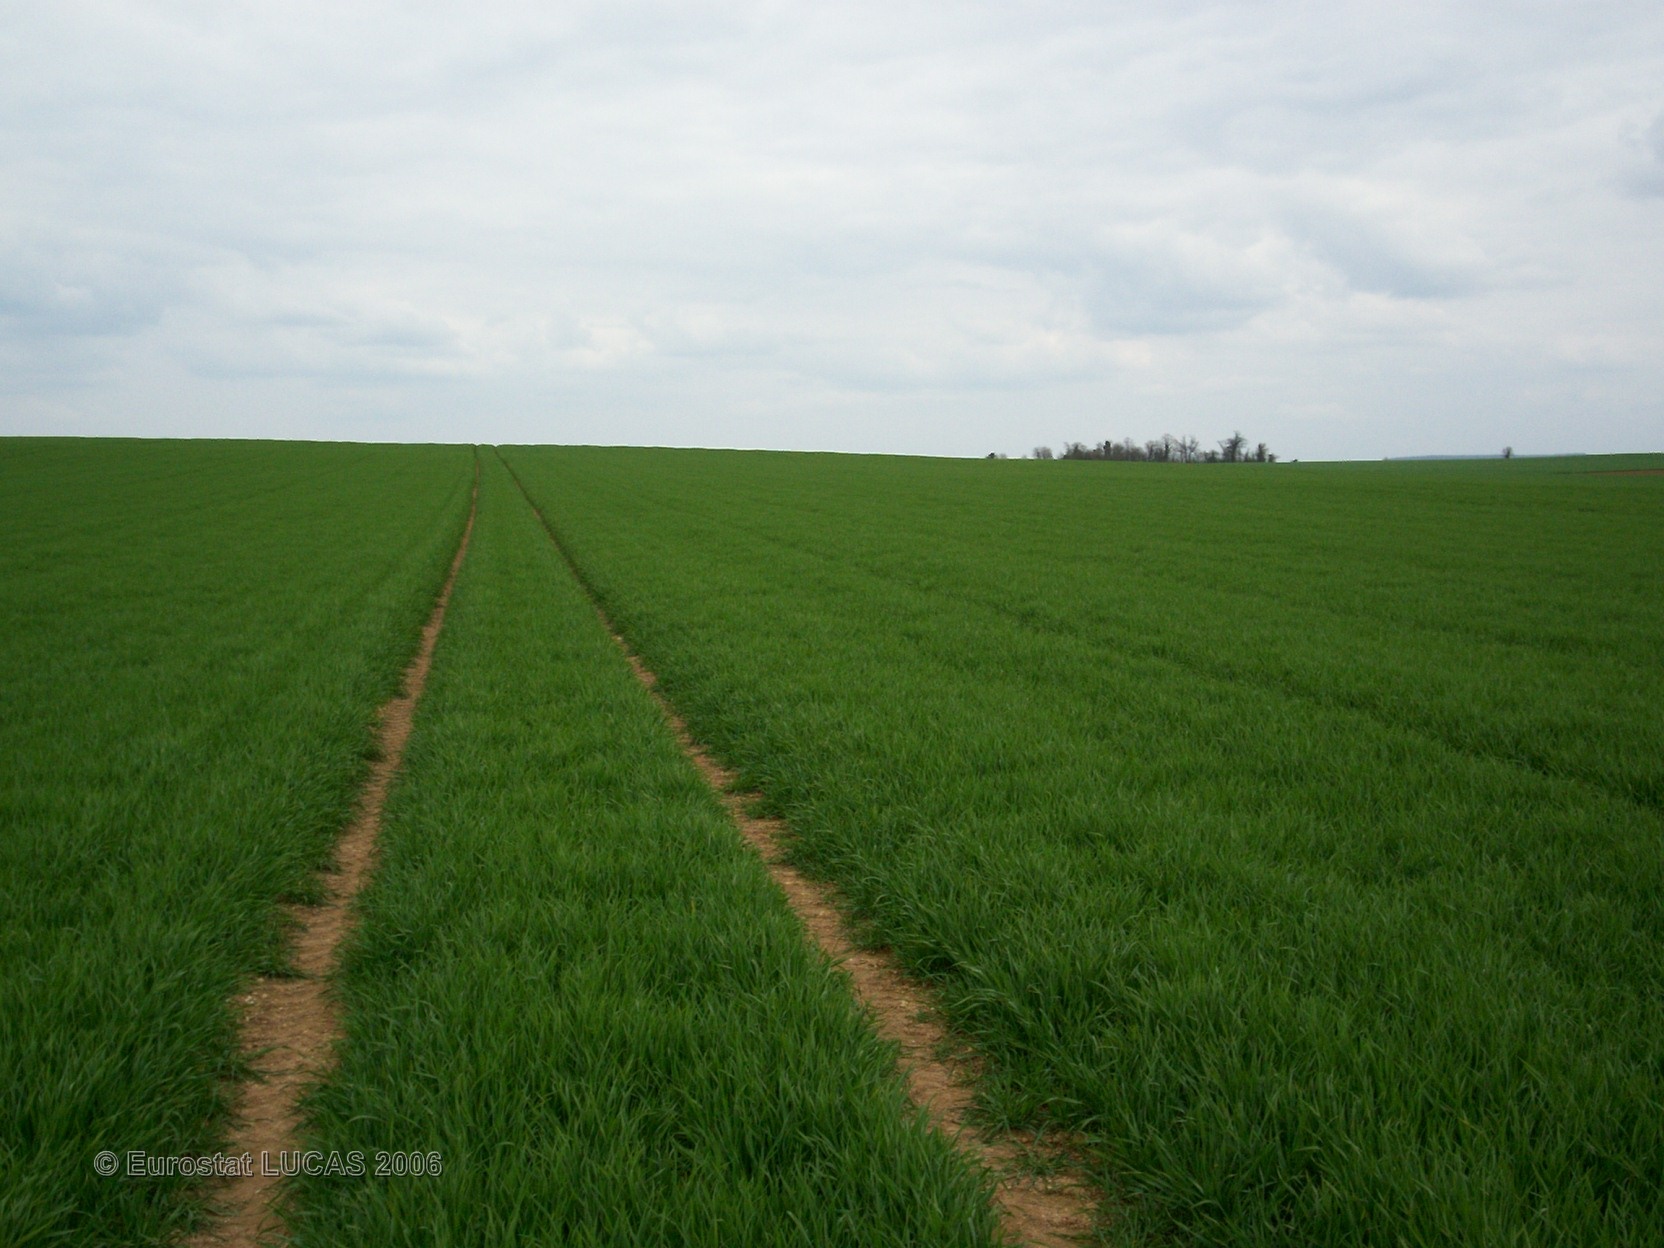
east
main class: Cropland
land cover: Barley
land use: Agriculture (excluding fallow land and kitchen gardens)
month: April
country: FR
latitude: 48.9579
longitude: -0.0695
